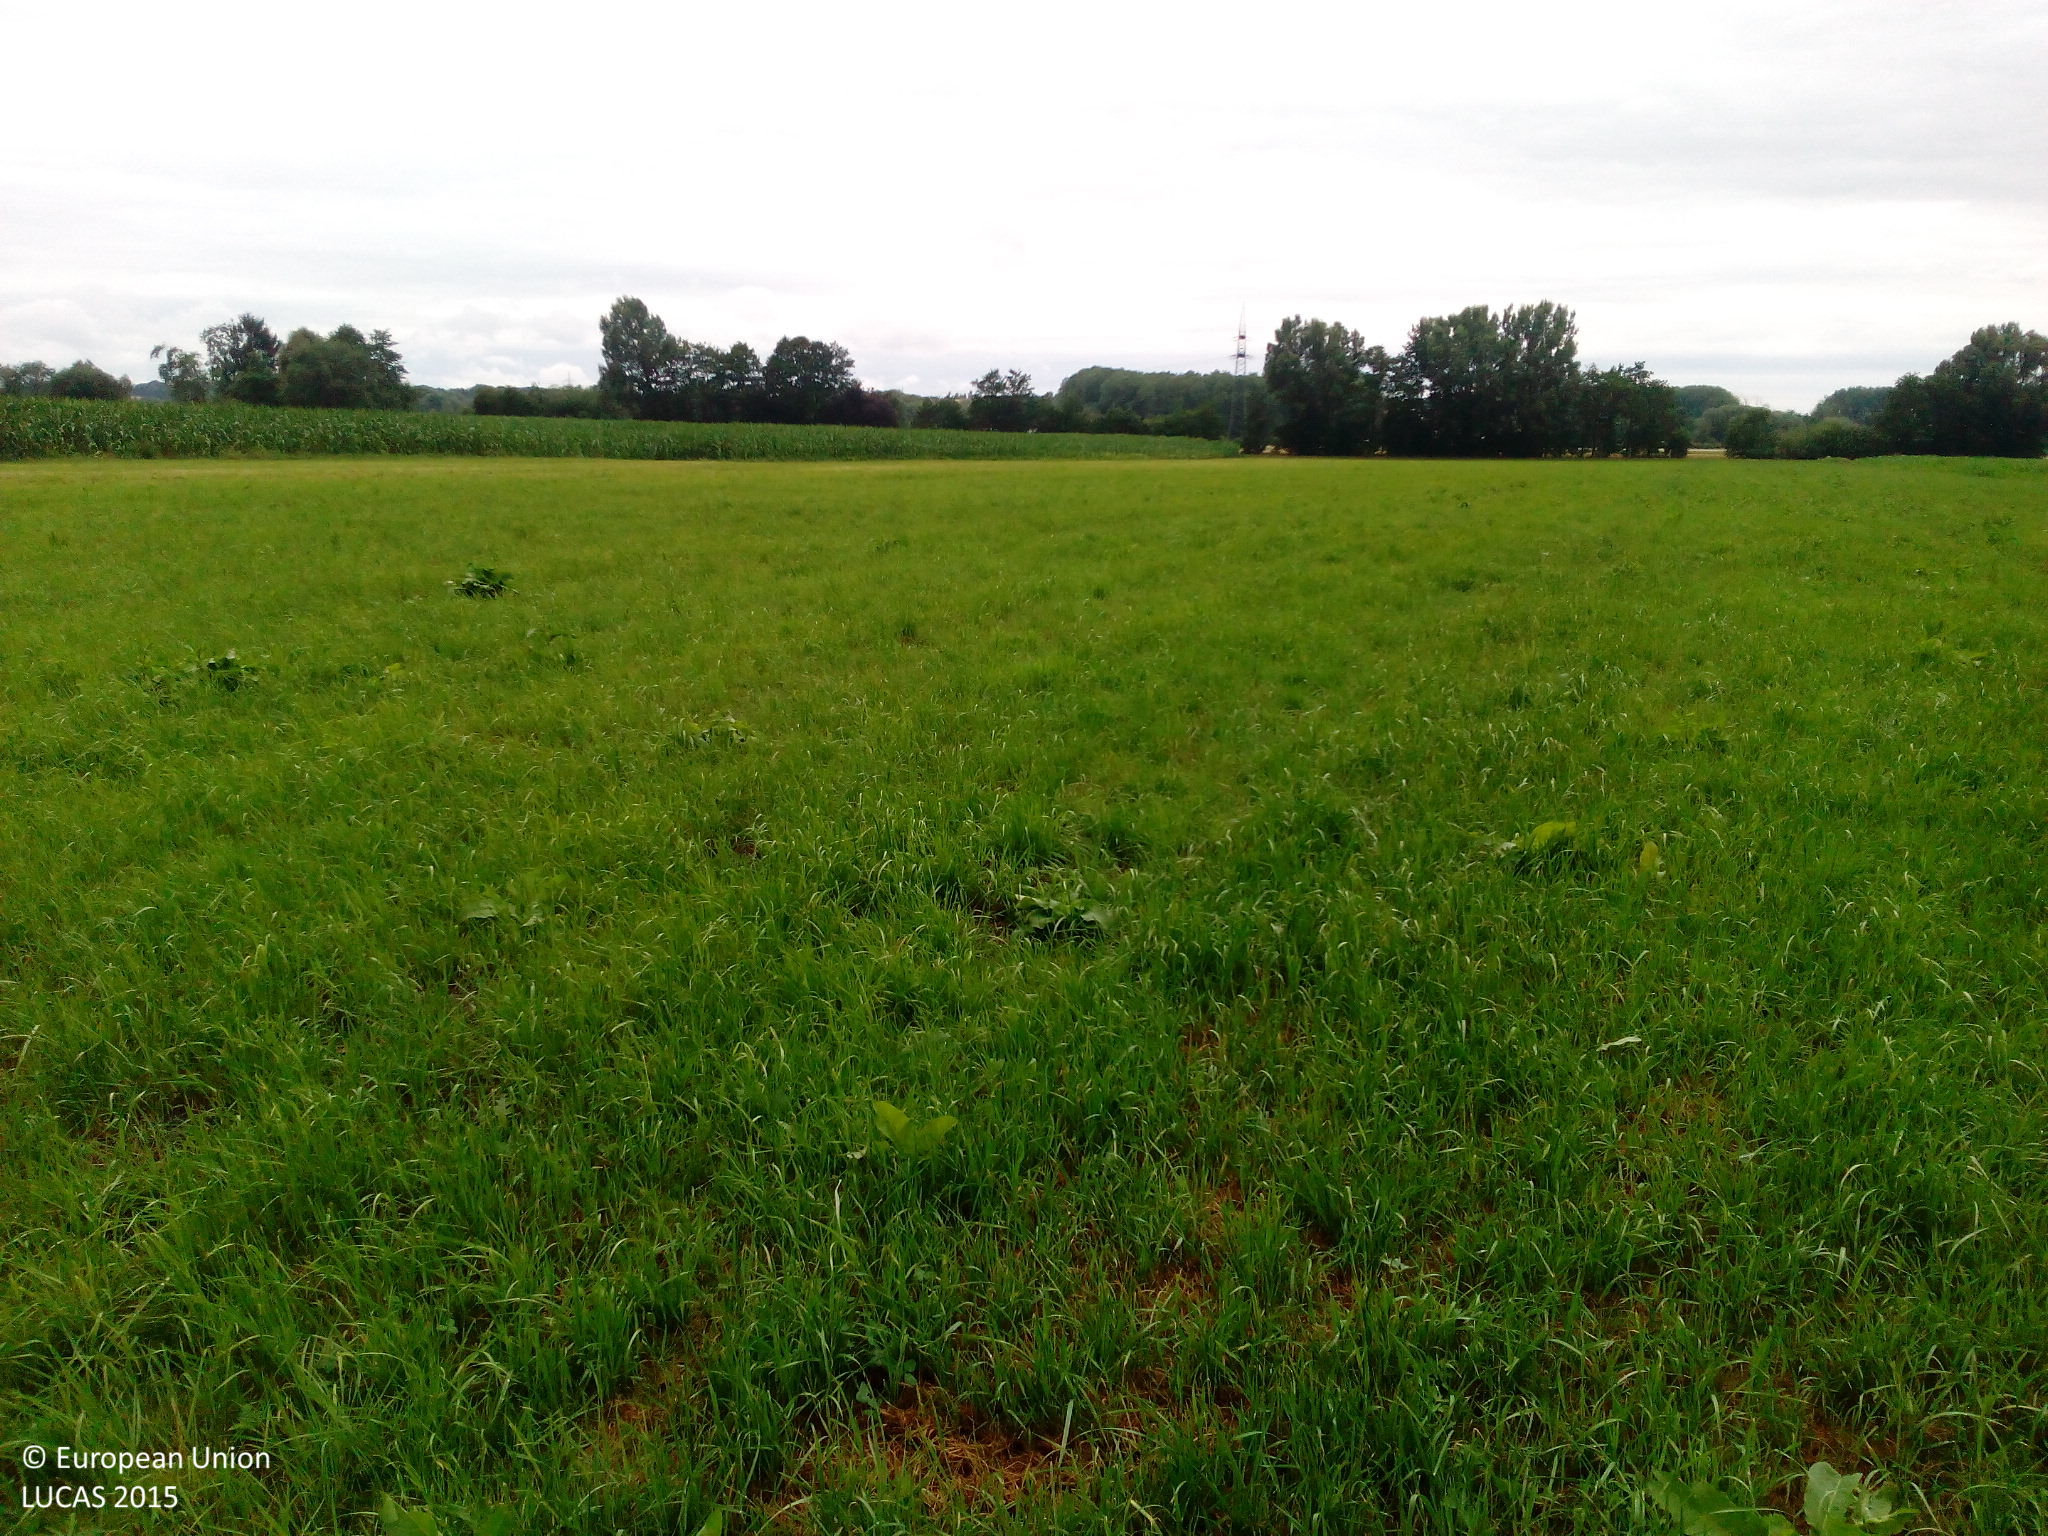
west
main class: Grassland
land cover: Grassland without tree/shrub cover
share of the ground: > 75 %
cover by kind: herbaceous plants 80 %, unconsolidated bare surface 15 %, lichens and mosses 5 %
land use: Agriculture (excluding fallow land and kitchen gardens)
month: July
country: DE
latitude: 48.6455
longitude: 11.4787
